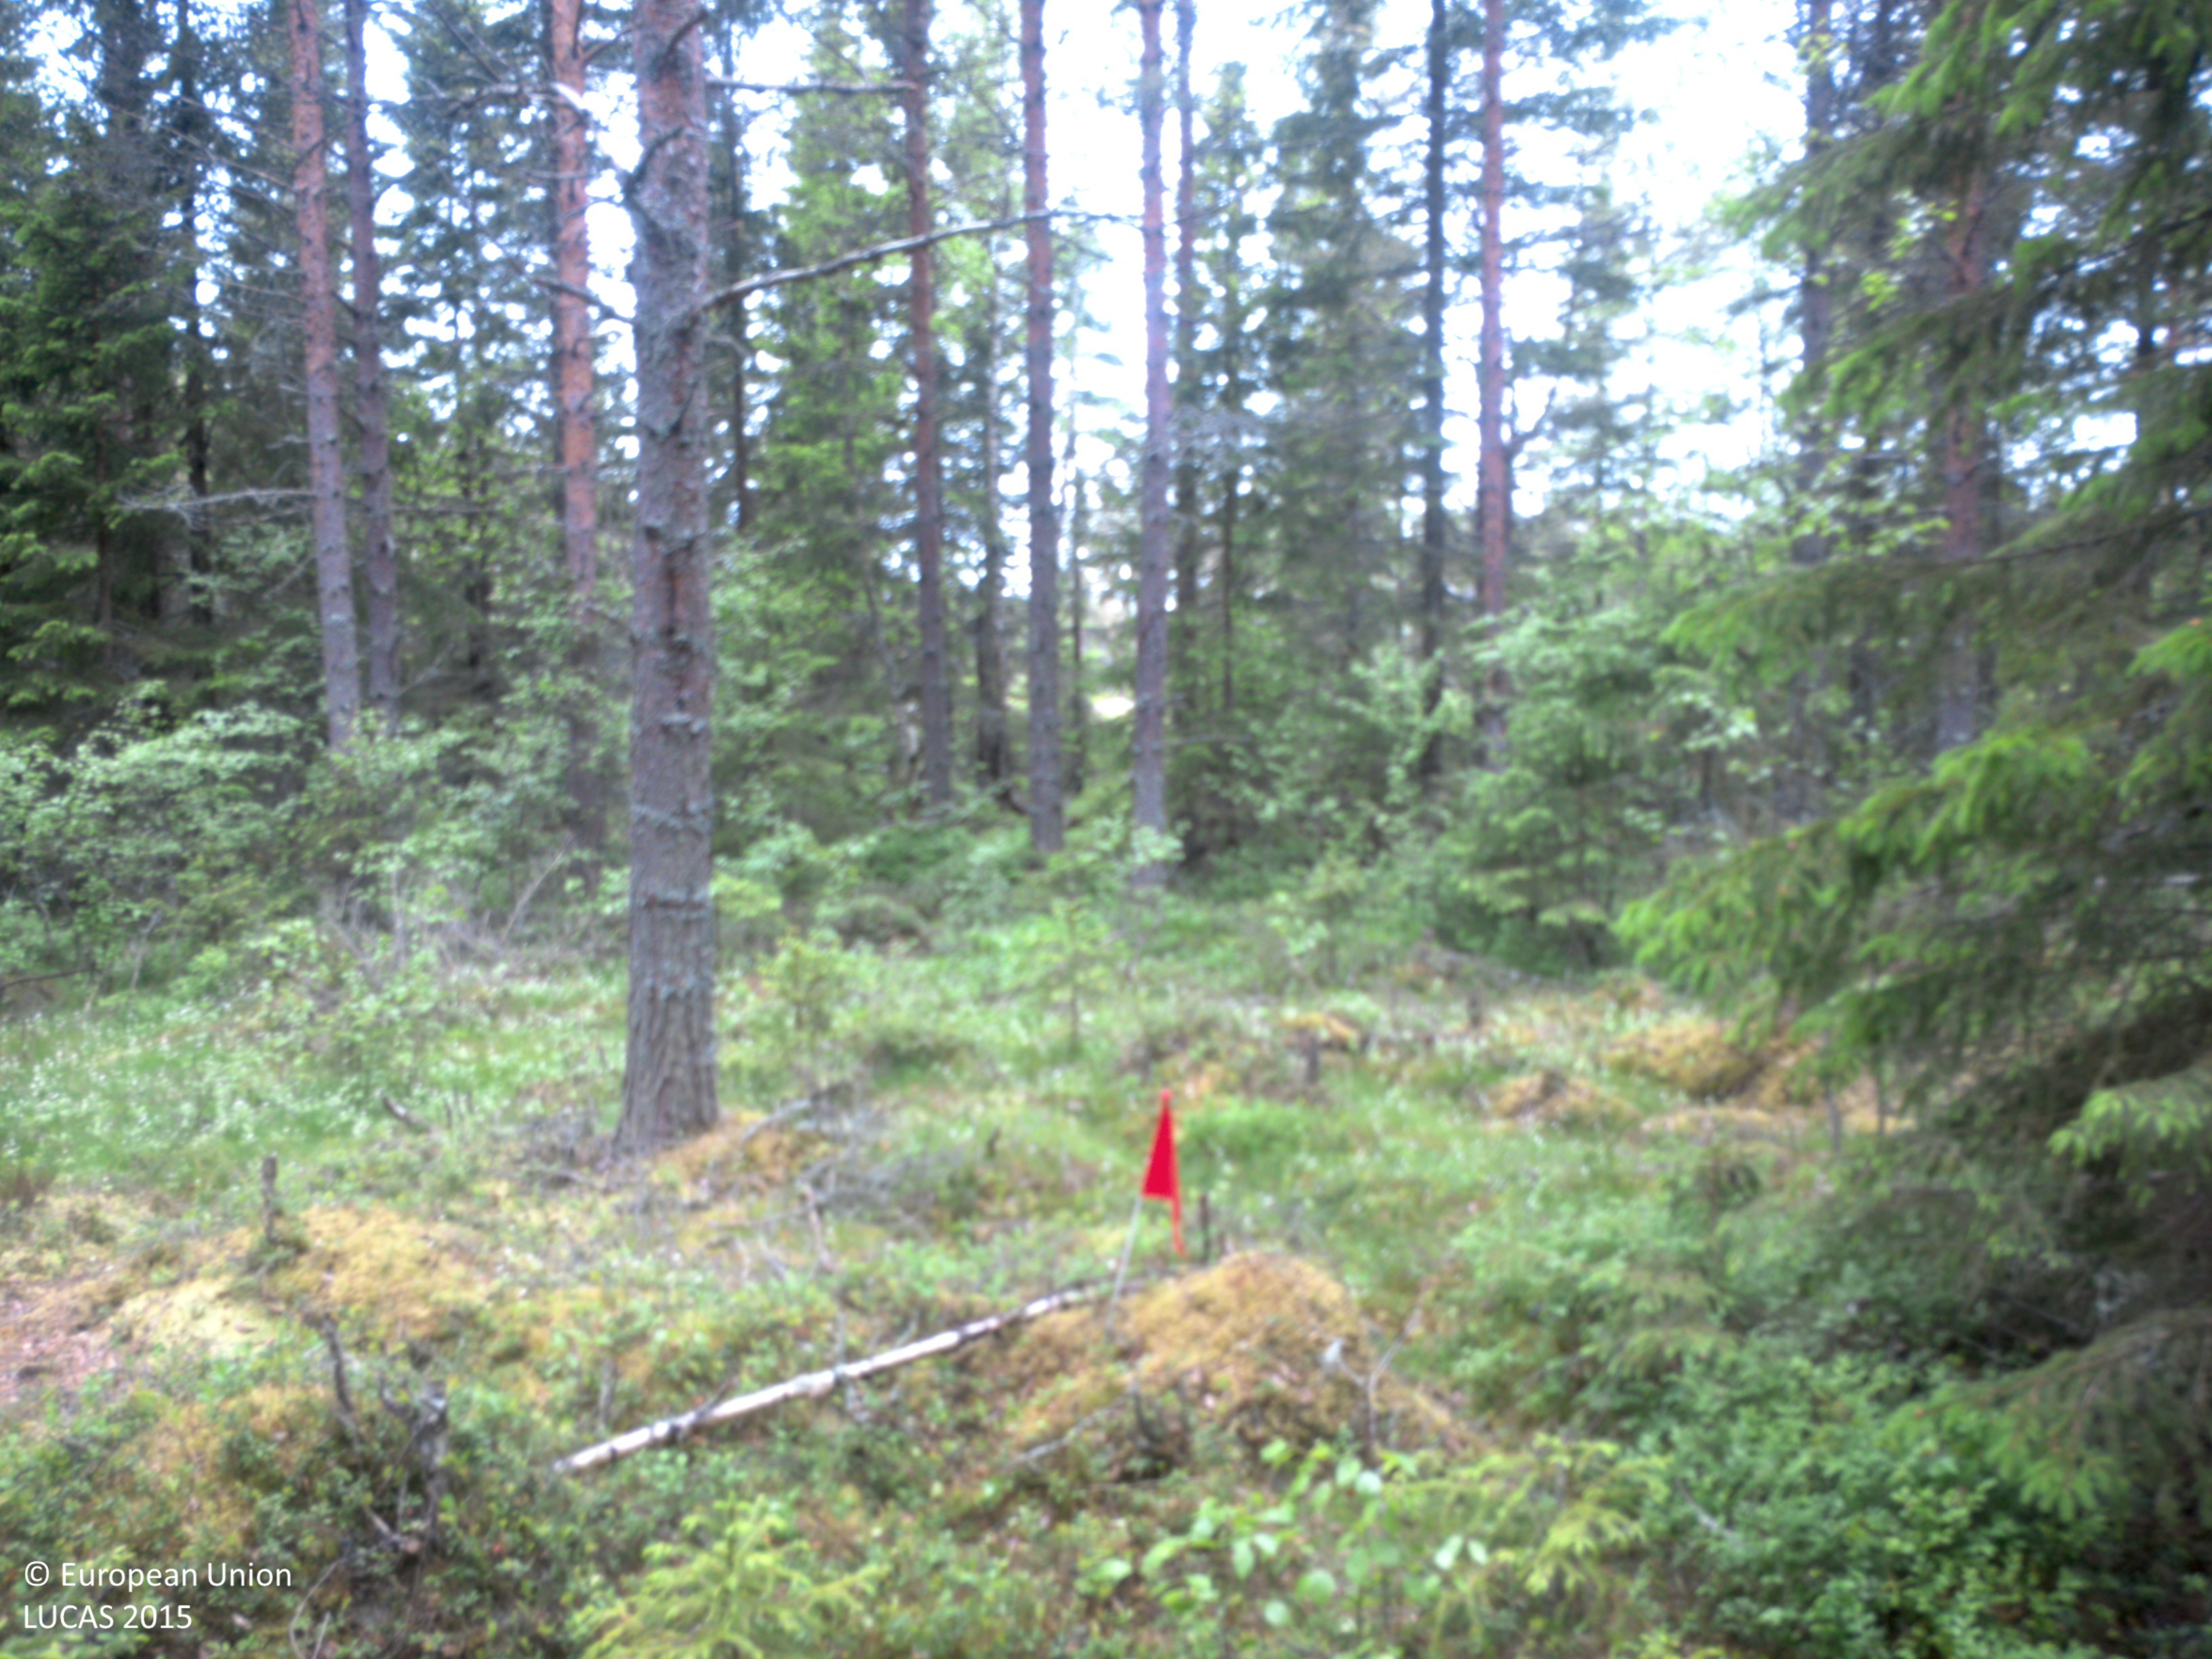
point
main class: Woodland
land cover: Other mixed woodland
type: boreal forest
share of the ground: 50 - 75 %
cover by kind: coniferous forest trees 40 %, broadleaved forest trees 25 %, lichens and mosses 20 %, shrubs 15 %
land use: Forestry
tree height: > 5 m
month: June
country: SE
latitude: 63.6283
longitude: 19.9699
